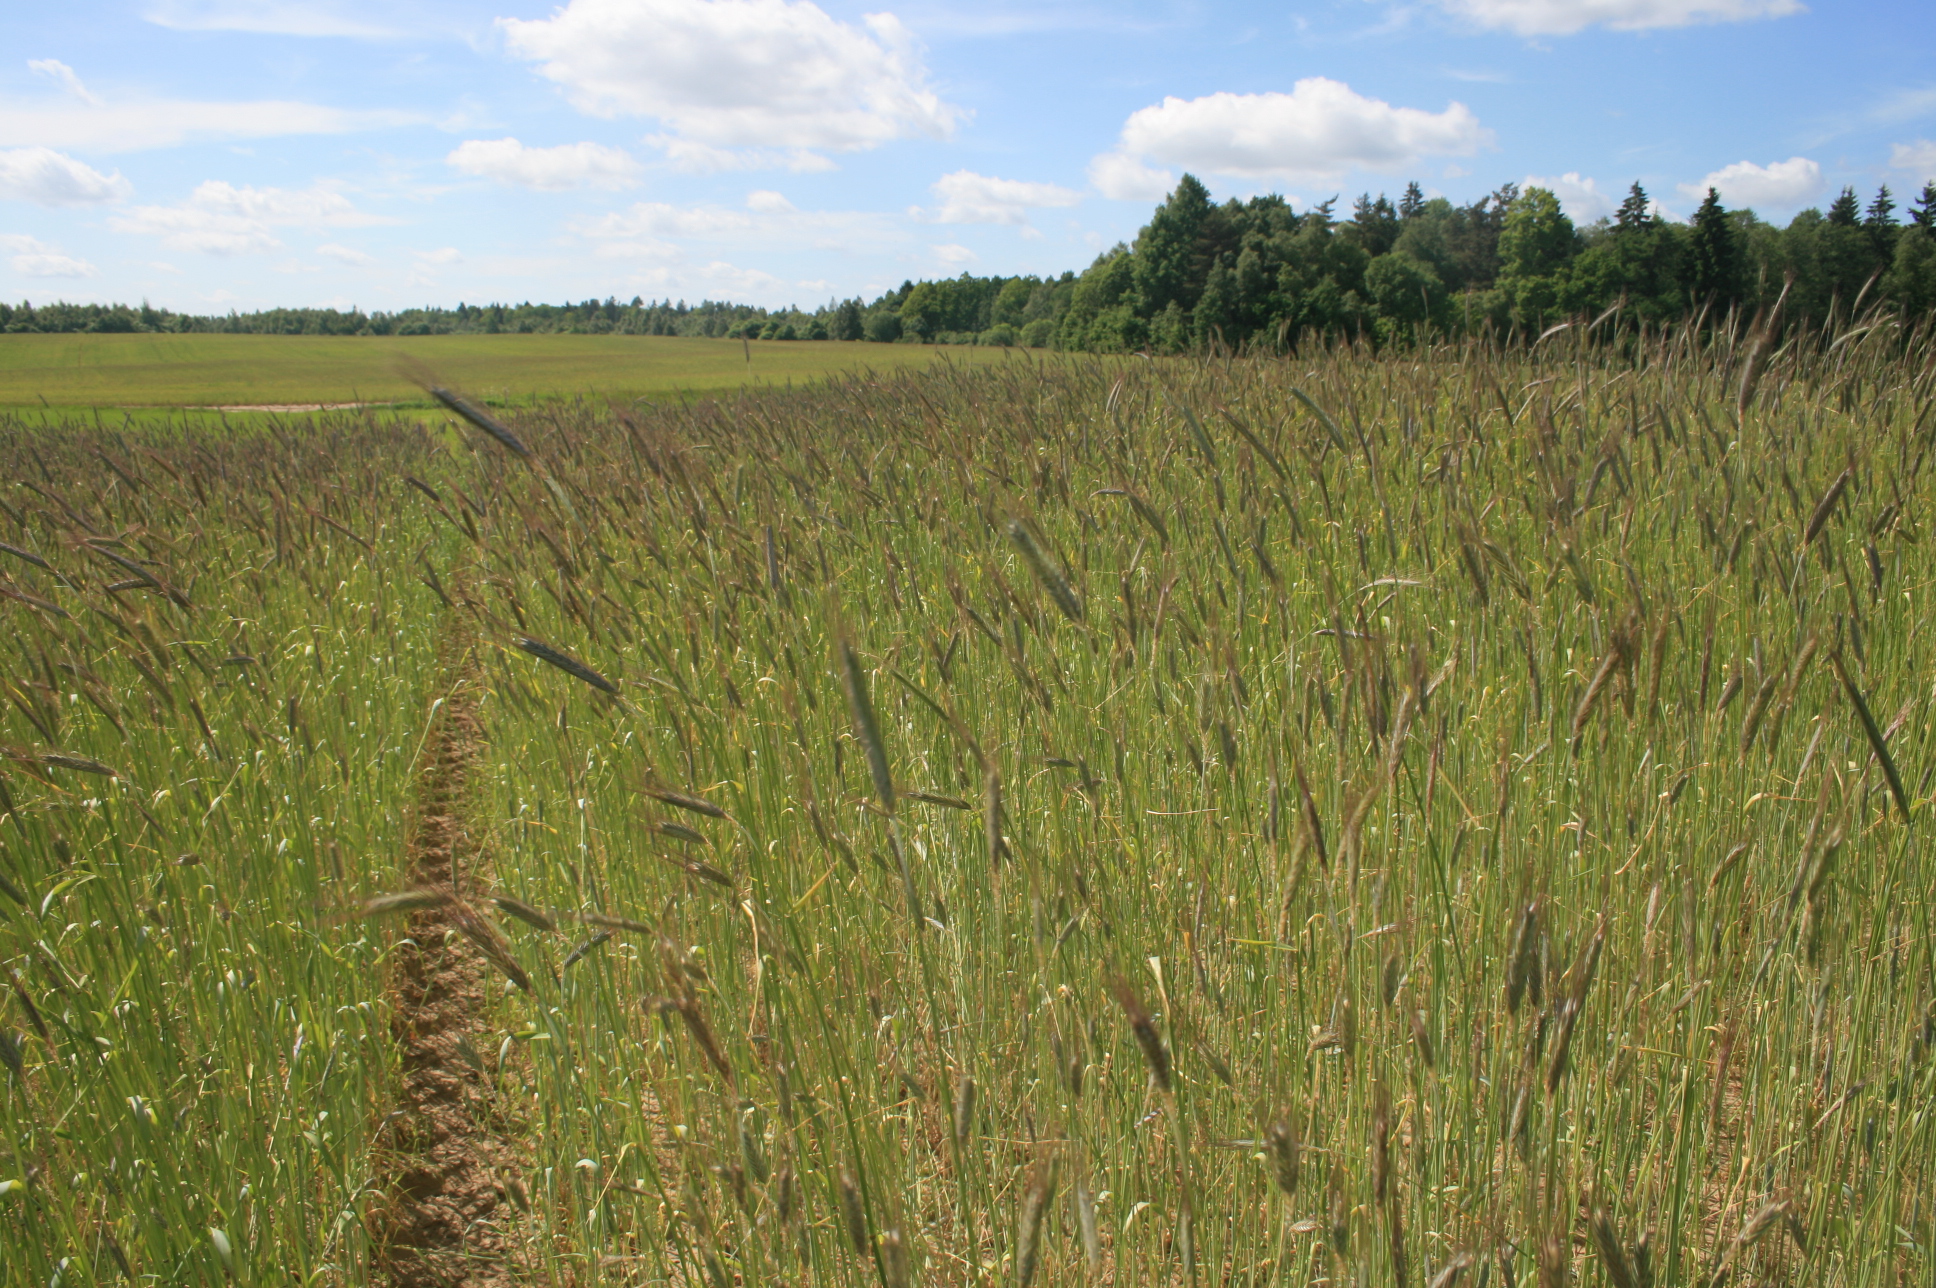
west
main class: Cropland
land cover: Rye
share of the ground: > 75 %
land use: Agriculture (excluding fallow land and kitchen gardens)
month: June
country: LT
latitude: 55.7561
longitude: 22.3106
